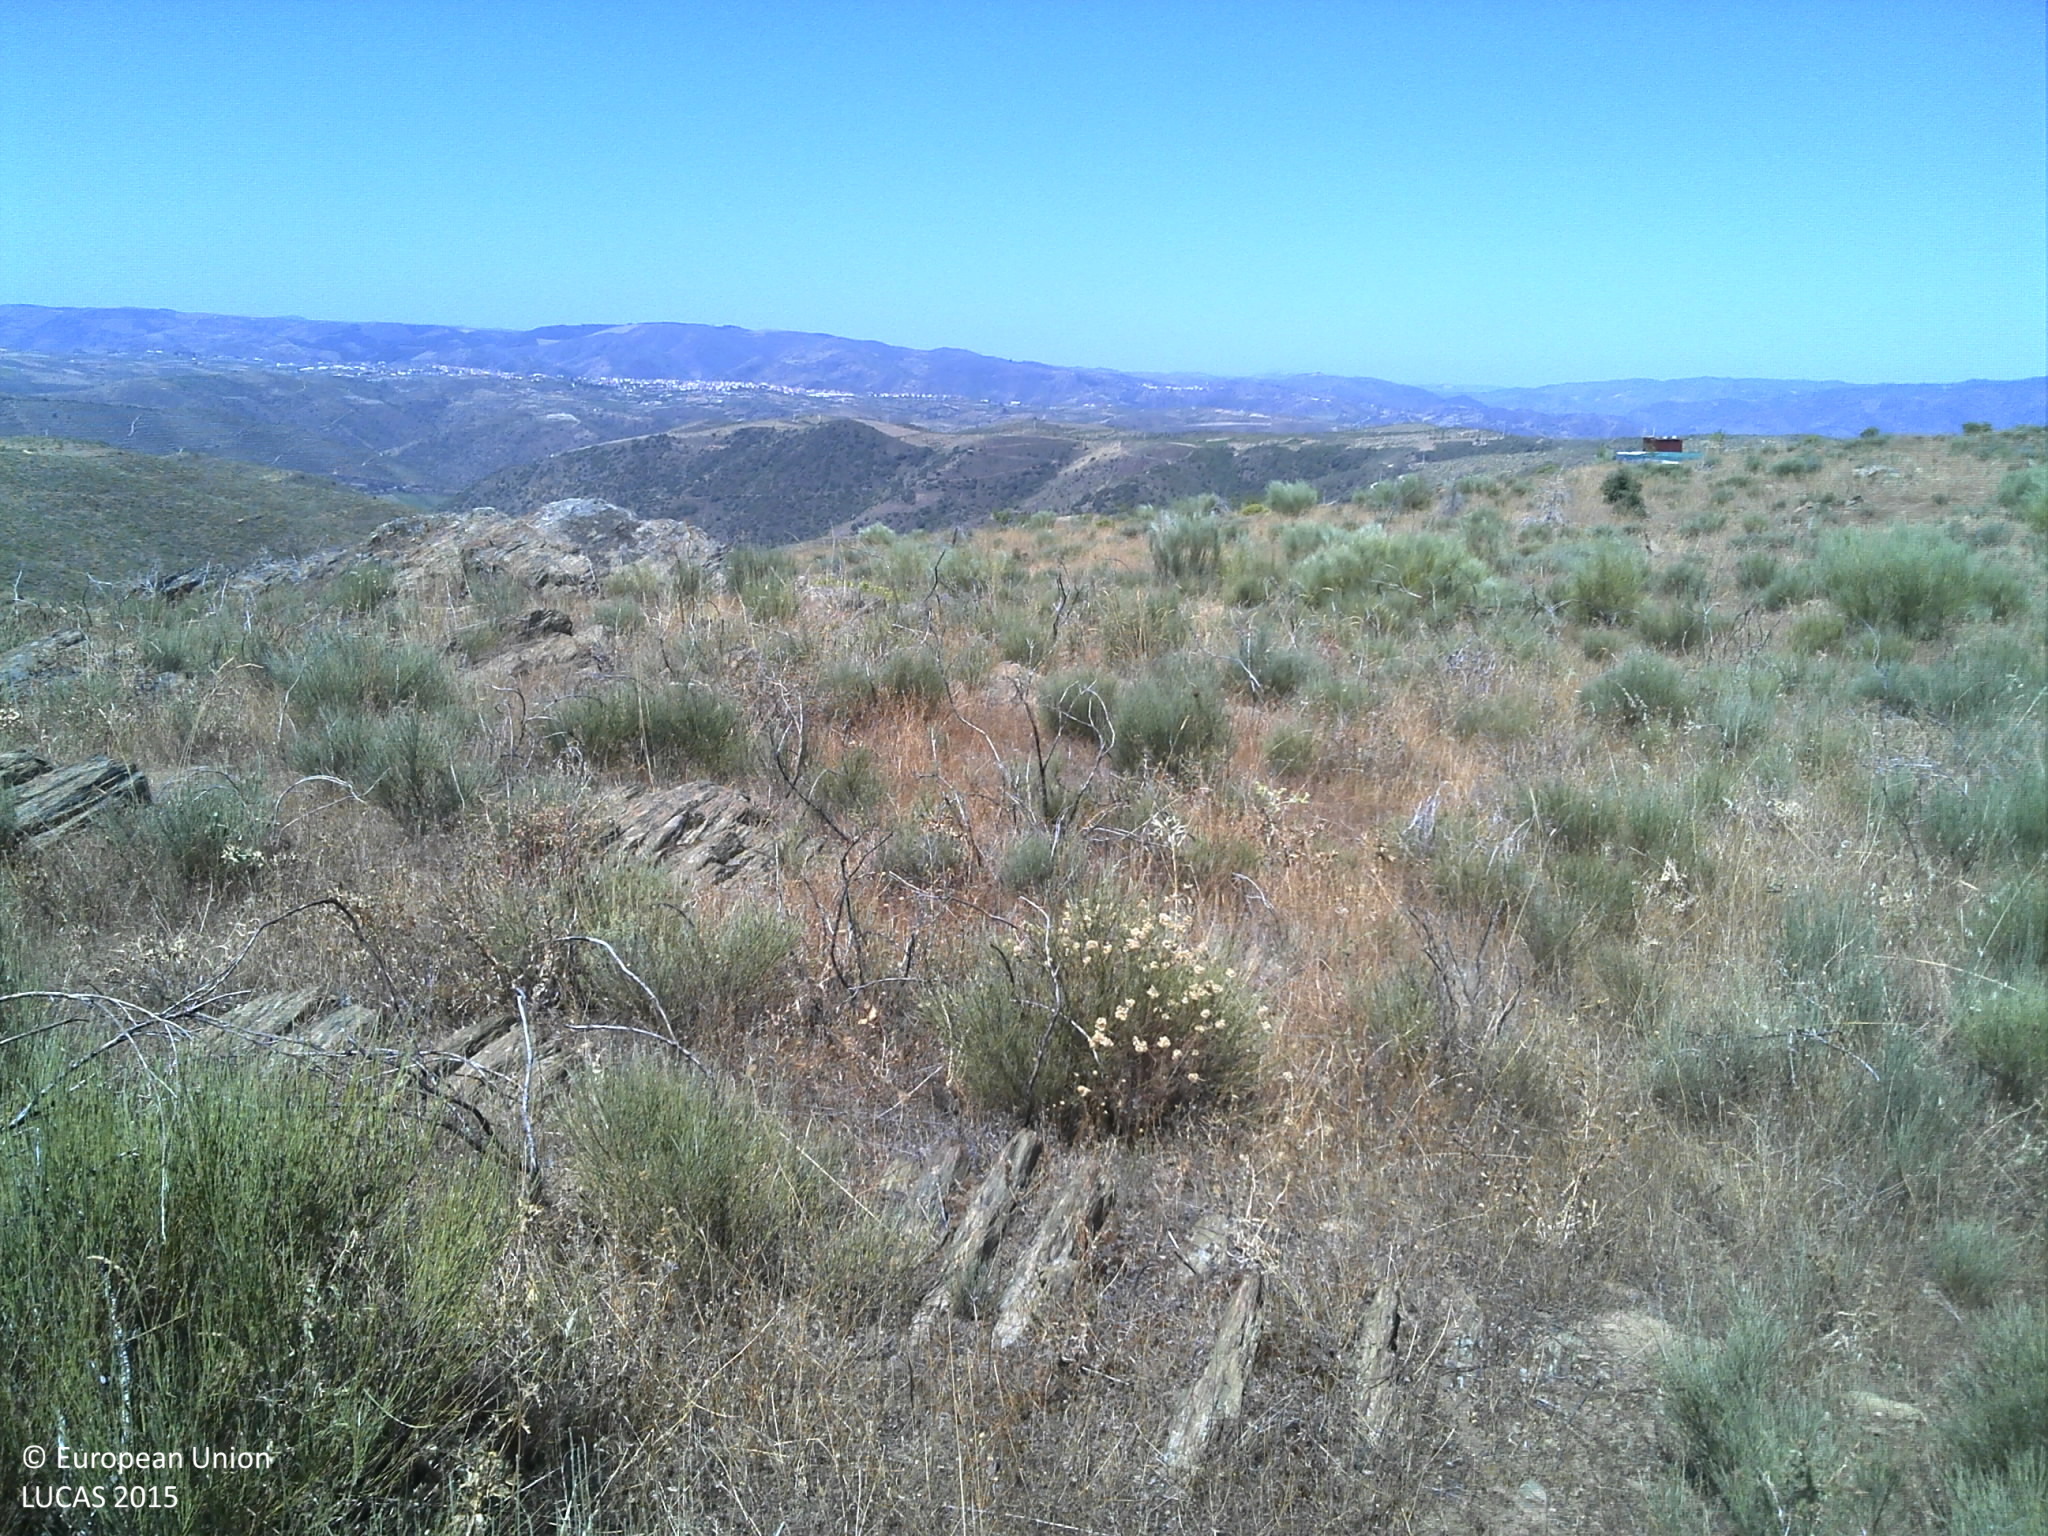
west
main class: Shrubland
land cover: Shrubland without tree cover
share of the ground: 50 - 75 %
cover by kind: shrubs 75 %, herbaceous plants 20 %, consolidated bare surface 5 %
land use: Abandoned areas
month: July
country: PT
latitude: 41.0855
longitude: -7.0486
